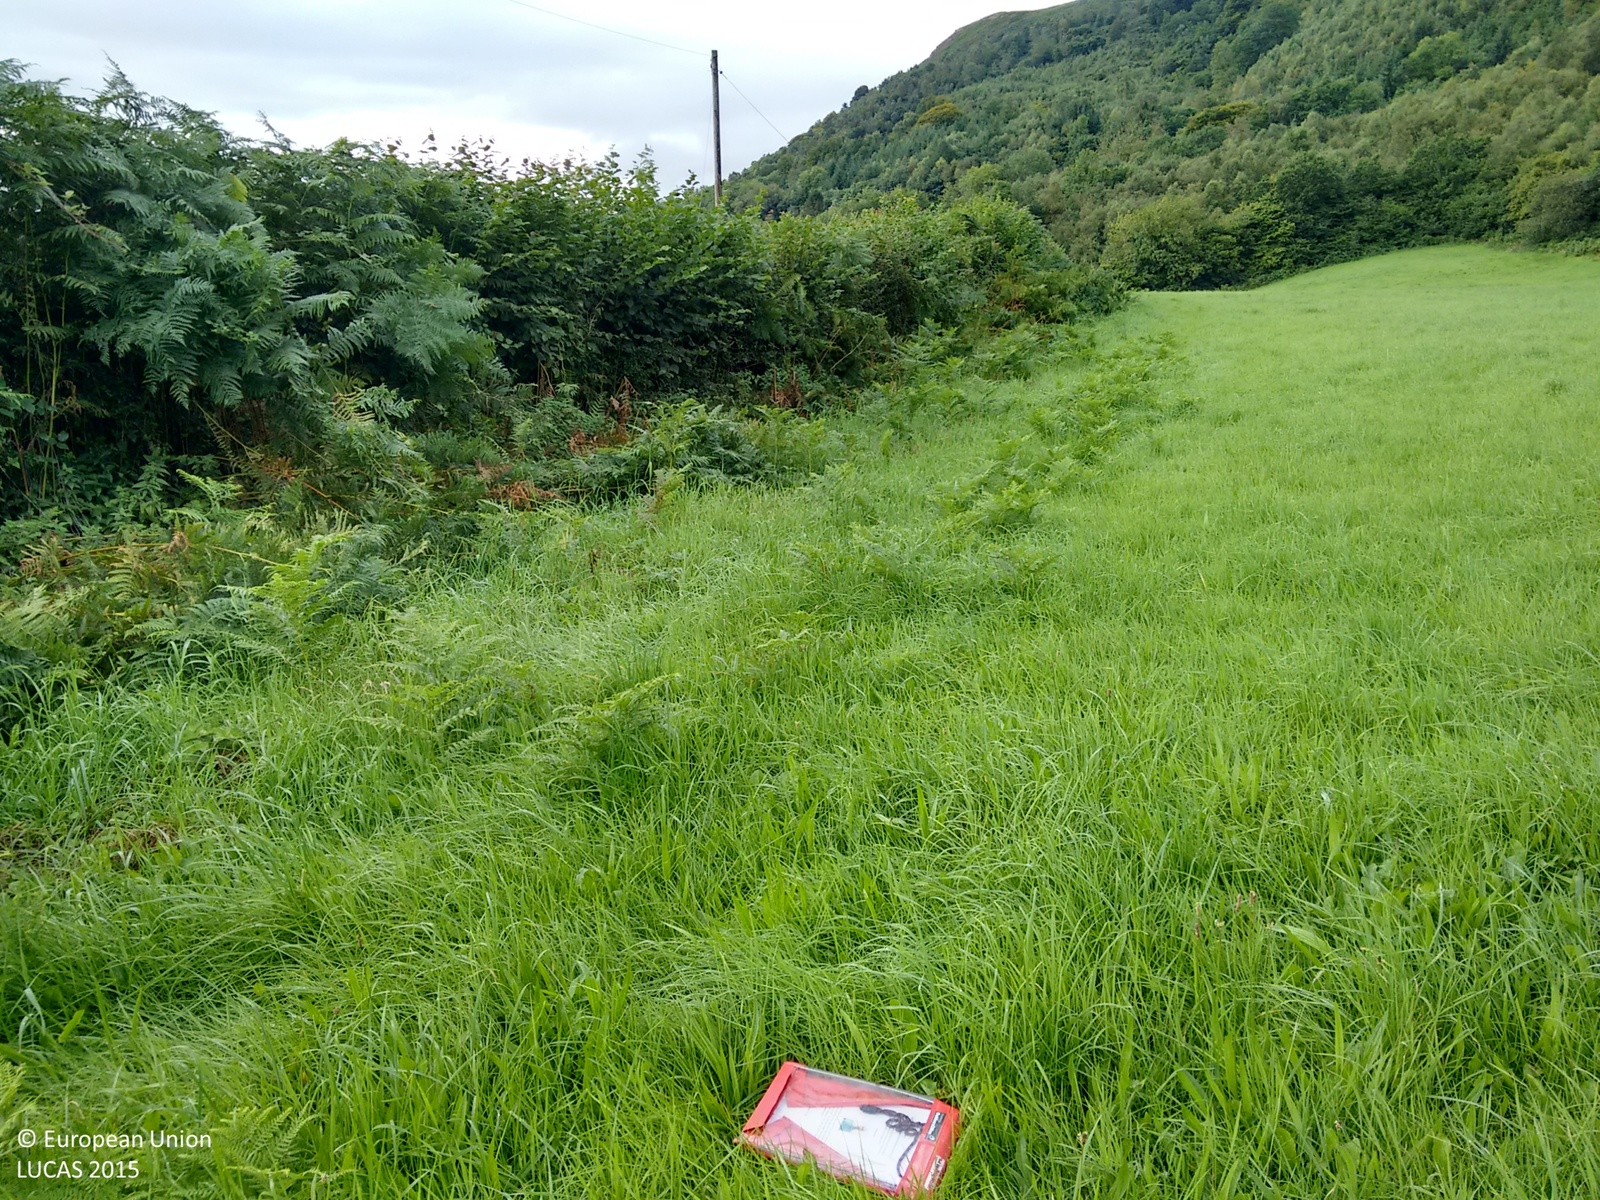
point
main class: Grassland
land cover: Grassland without tree/shrub cover
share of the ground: > 75 %
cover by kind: herbaceous plants 100 %
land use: Agriculture (excluding fallow land and kitchen gardens)
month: September
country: GB
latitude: 51.5544
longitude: -3.2770
